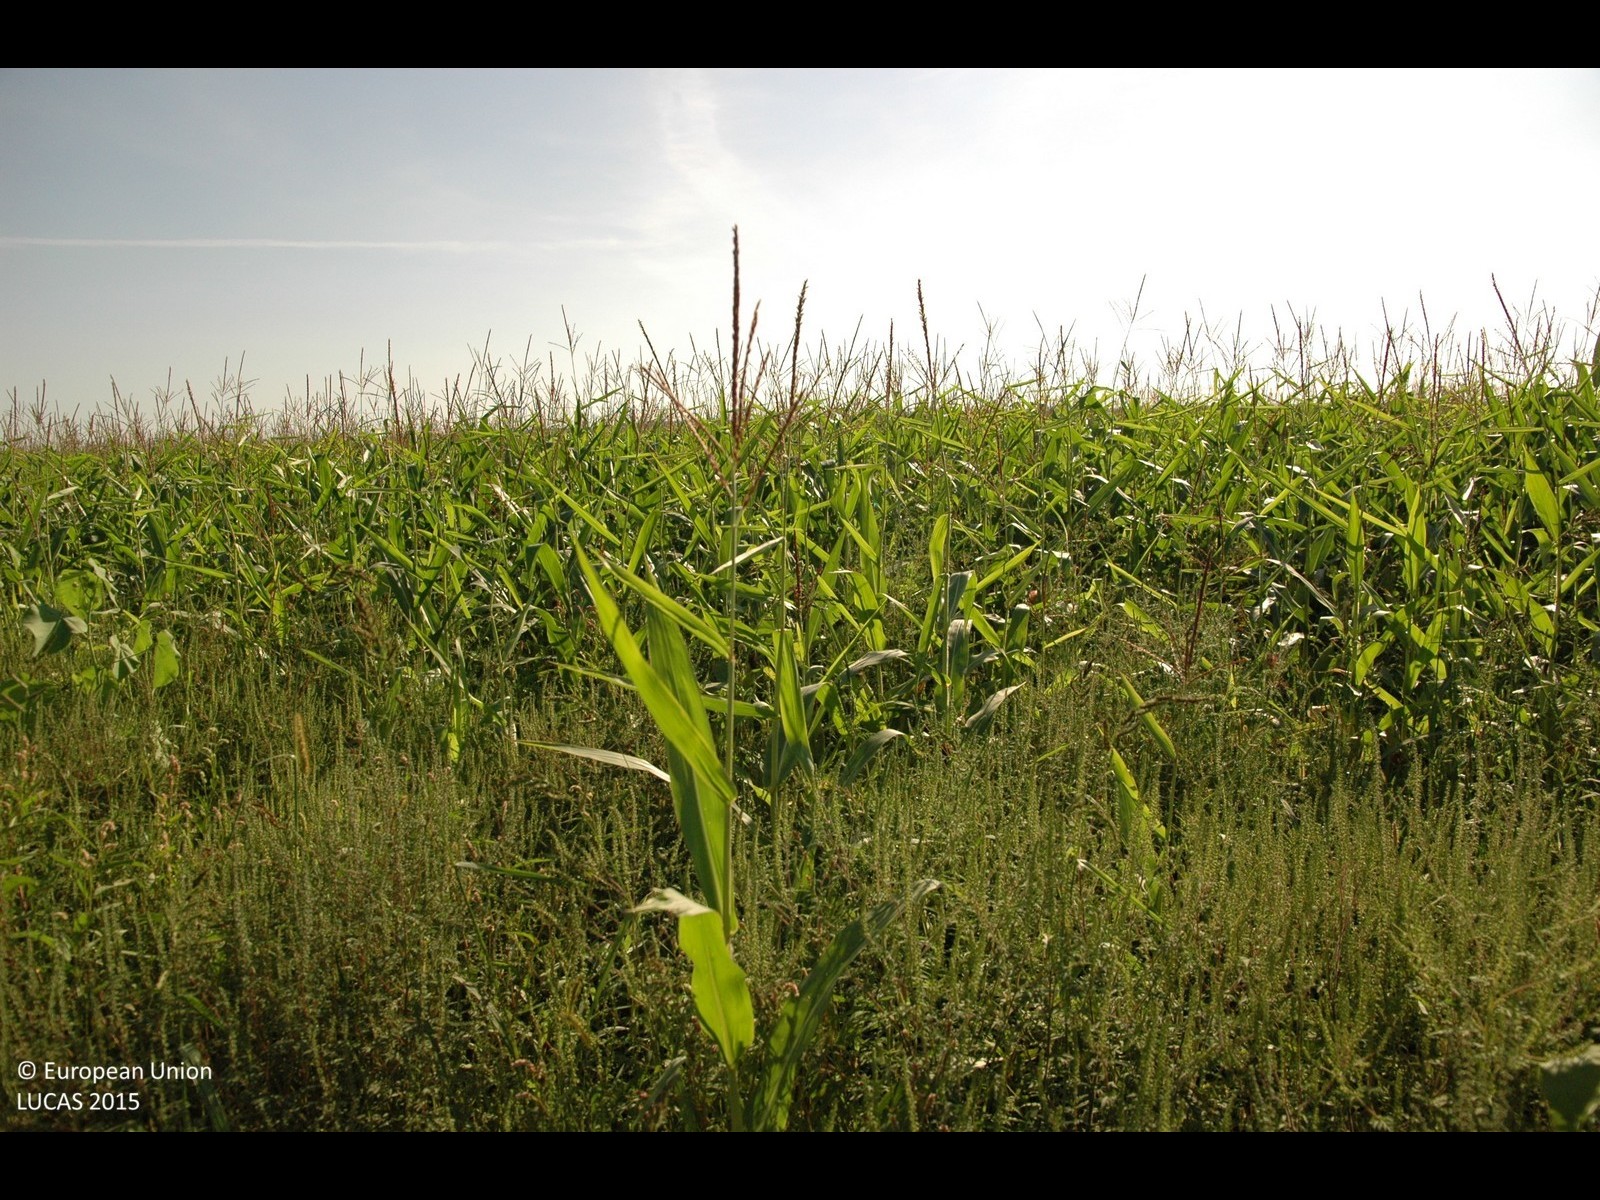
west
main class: Grassland
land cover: Spontaneously vegetated surfaces
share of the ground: > 75 %
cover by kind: herbaceous plants 100 %
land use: Fallow land
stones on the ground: < 10 %
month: August
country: HR
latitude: 46.1250
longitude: 16.9512
